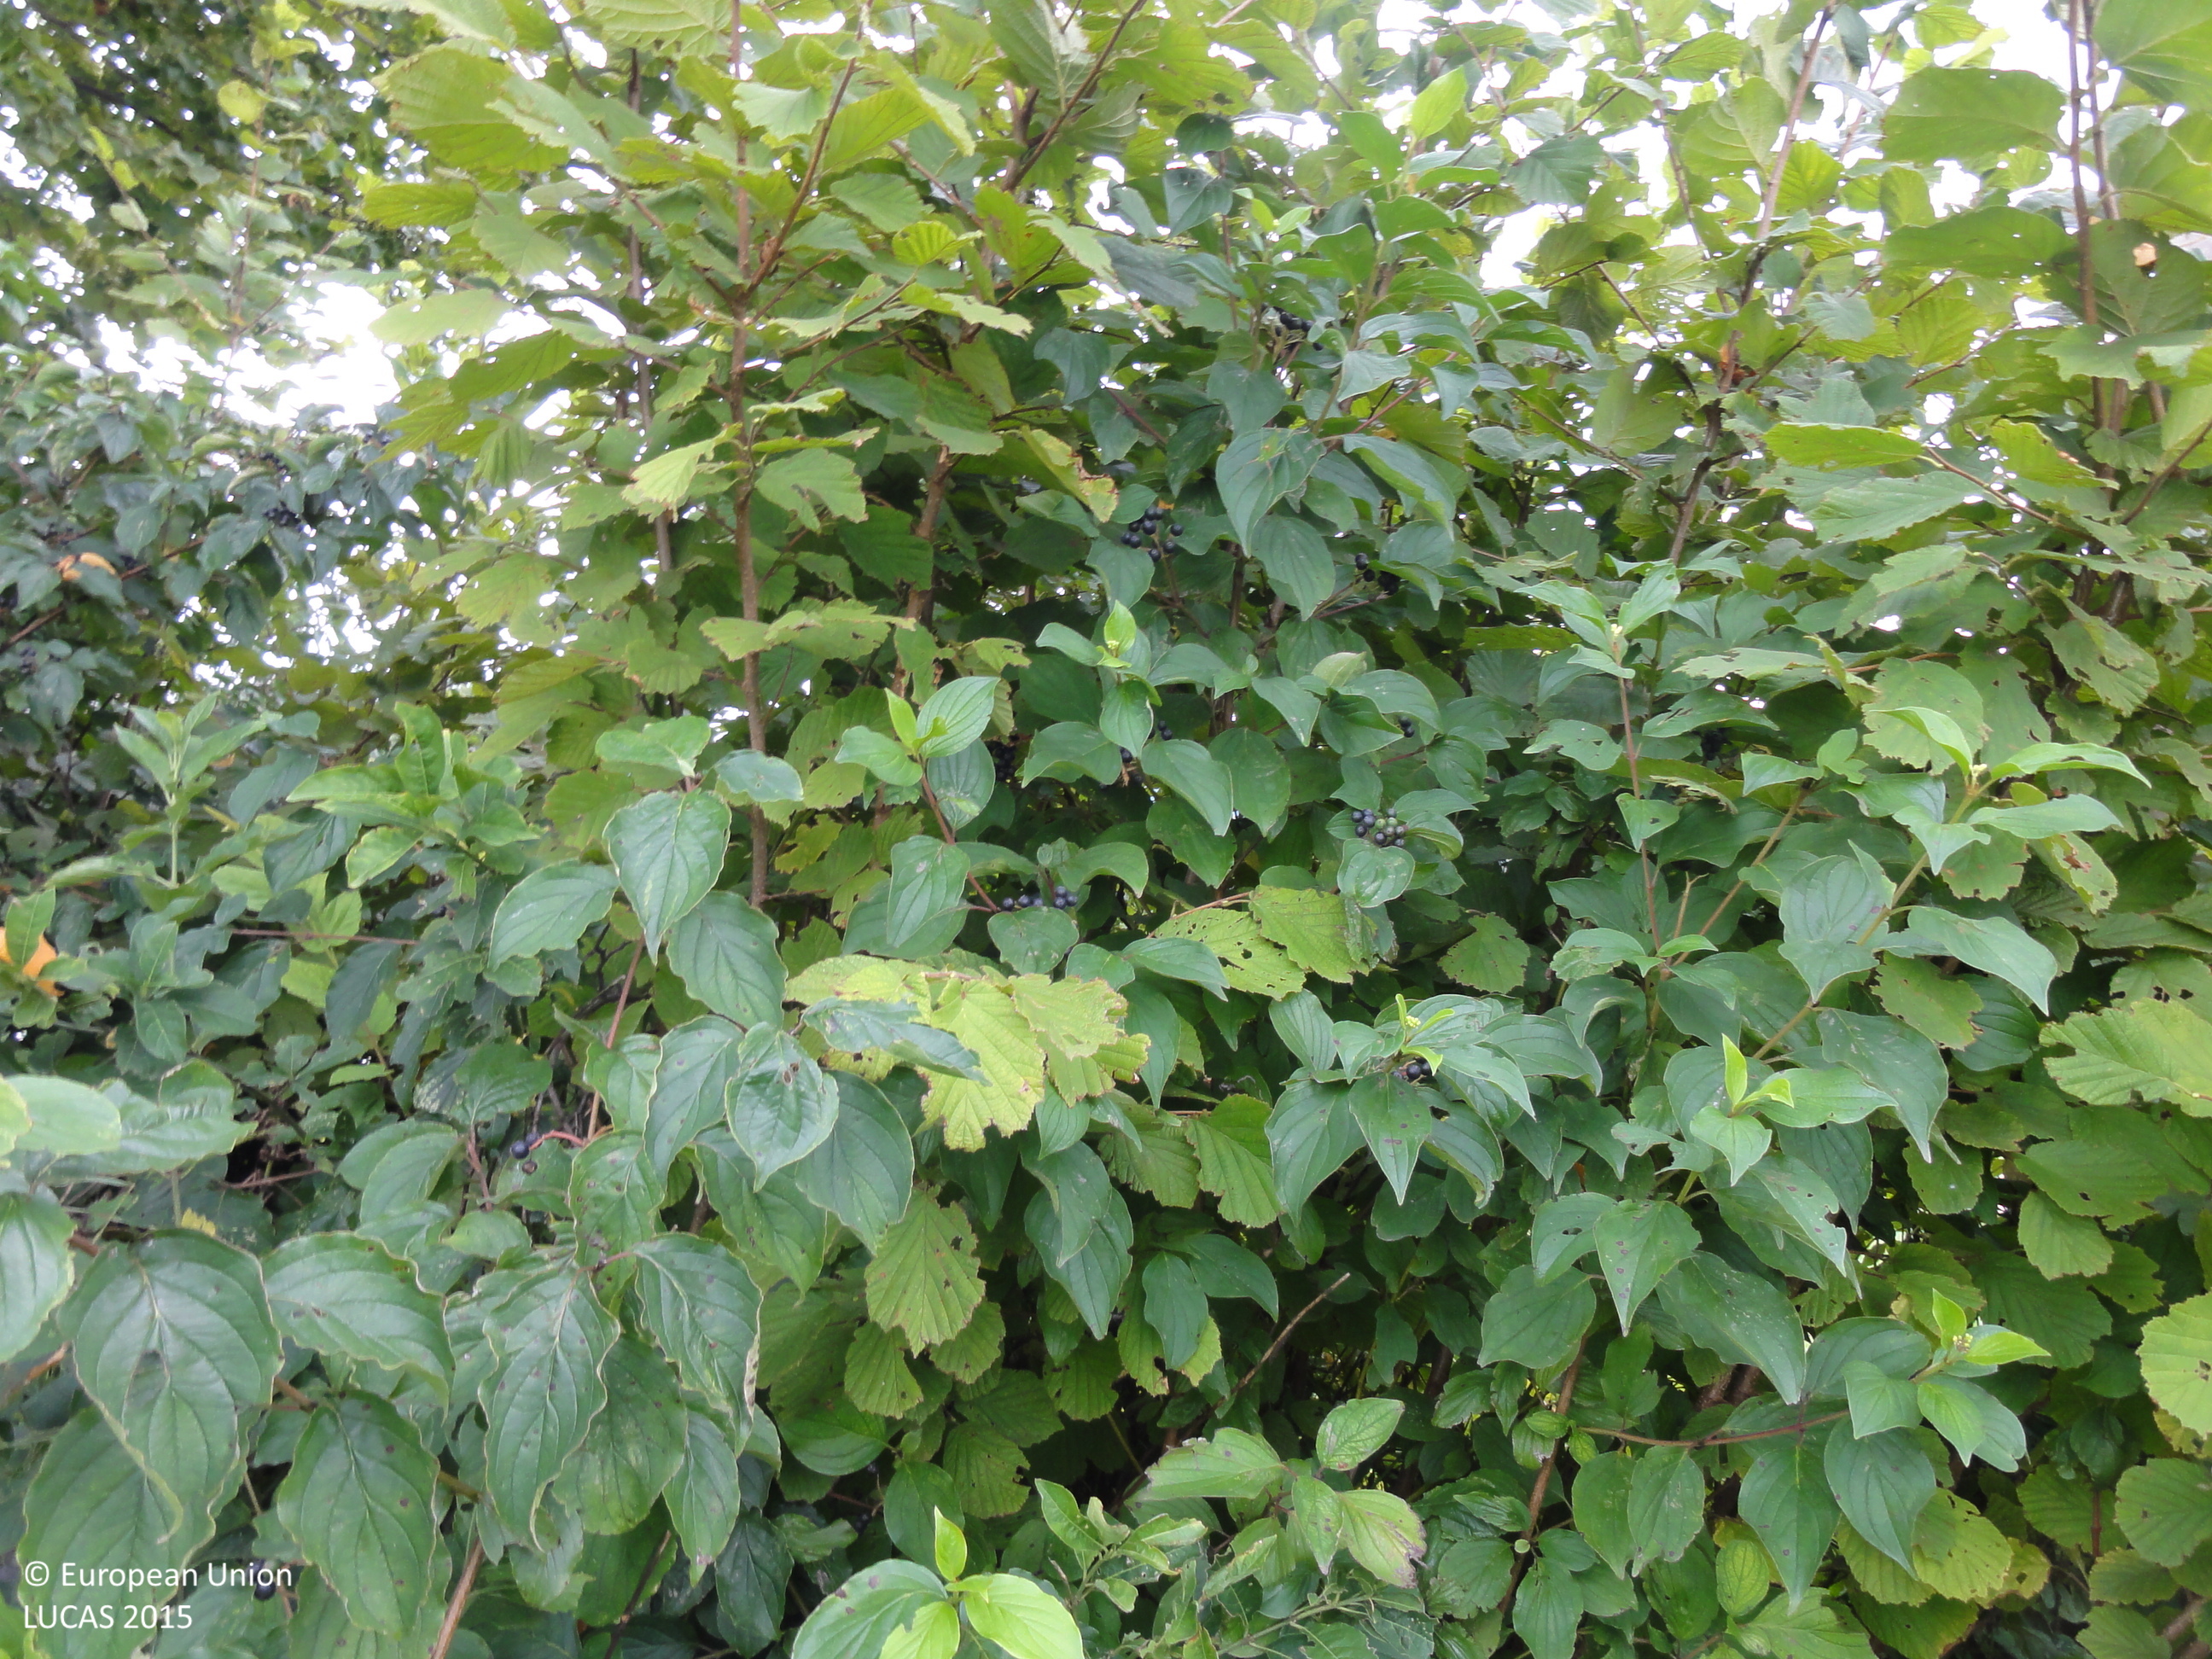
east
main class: Artificial land
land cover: Other artificial areas
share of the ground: < 10 %
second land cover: Shrubland with sparse tree cover
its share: > 75 %
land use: Electricity, gas and thermal power distribution
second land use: Agriculture (excluding fallow land and kitchen gardens)
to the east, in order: Artificial constructions in urban areas; Shrubland with sparse tree cover; Grassland without tree/shrub cover; Paved roads, cycling and walking lanes; Grassland without tree/shrub cover; Tracks; Grassland without tree/shrub cover; Broadleaved woodland; Pine dominated mixed woodland; Broadleaved woodland; Rivers and streams; Broadleaved woodland
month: August
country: SI
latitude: 46.1150
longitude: 14.8491
